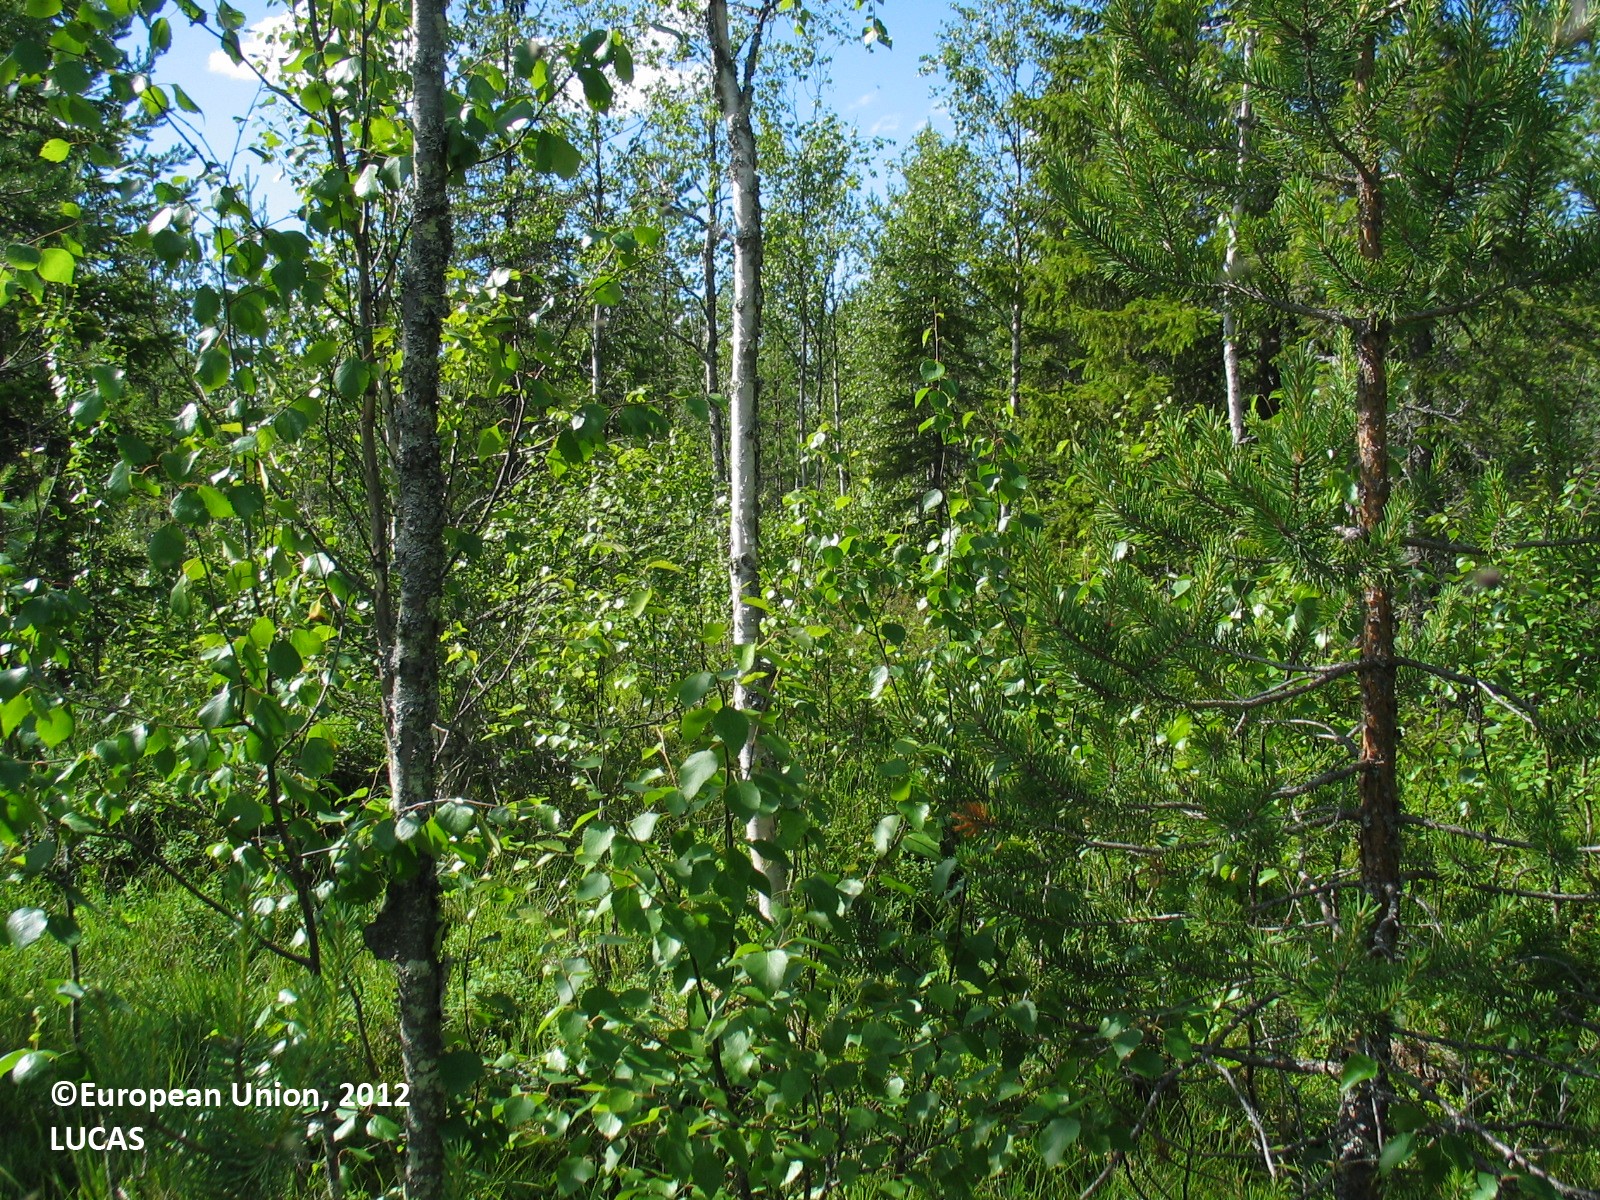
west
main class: Woodland
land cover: Other mixed woodland
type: mire and swamp forests
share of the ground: 25 - 50 %
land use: Forestry
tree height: > 5 m
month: July
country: FI
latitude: 65.9565
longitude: 24.9513
